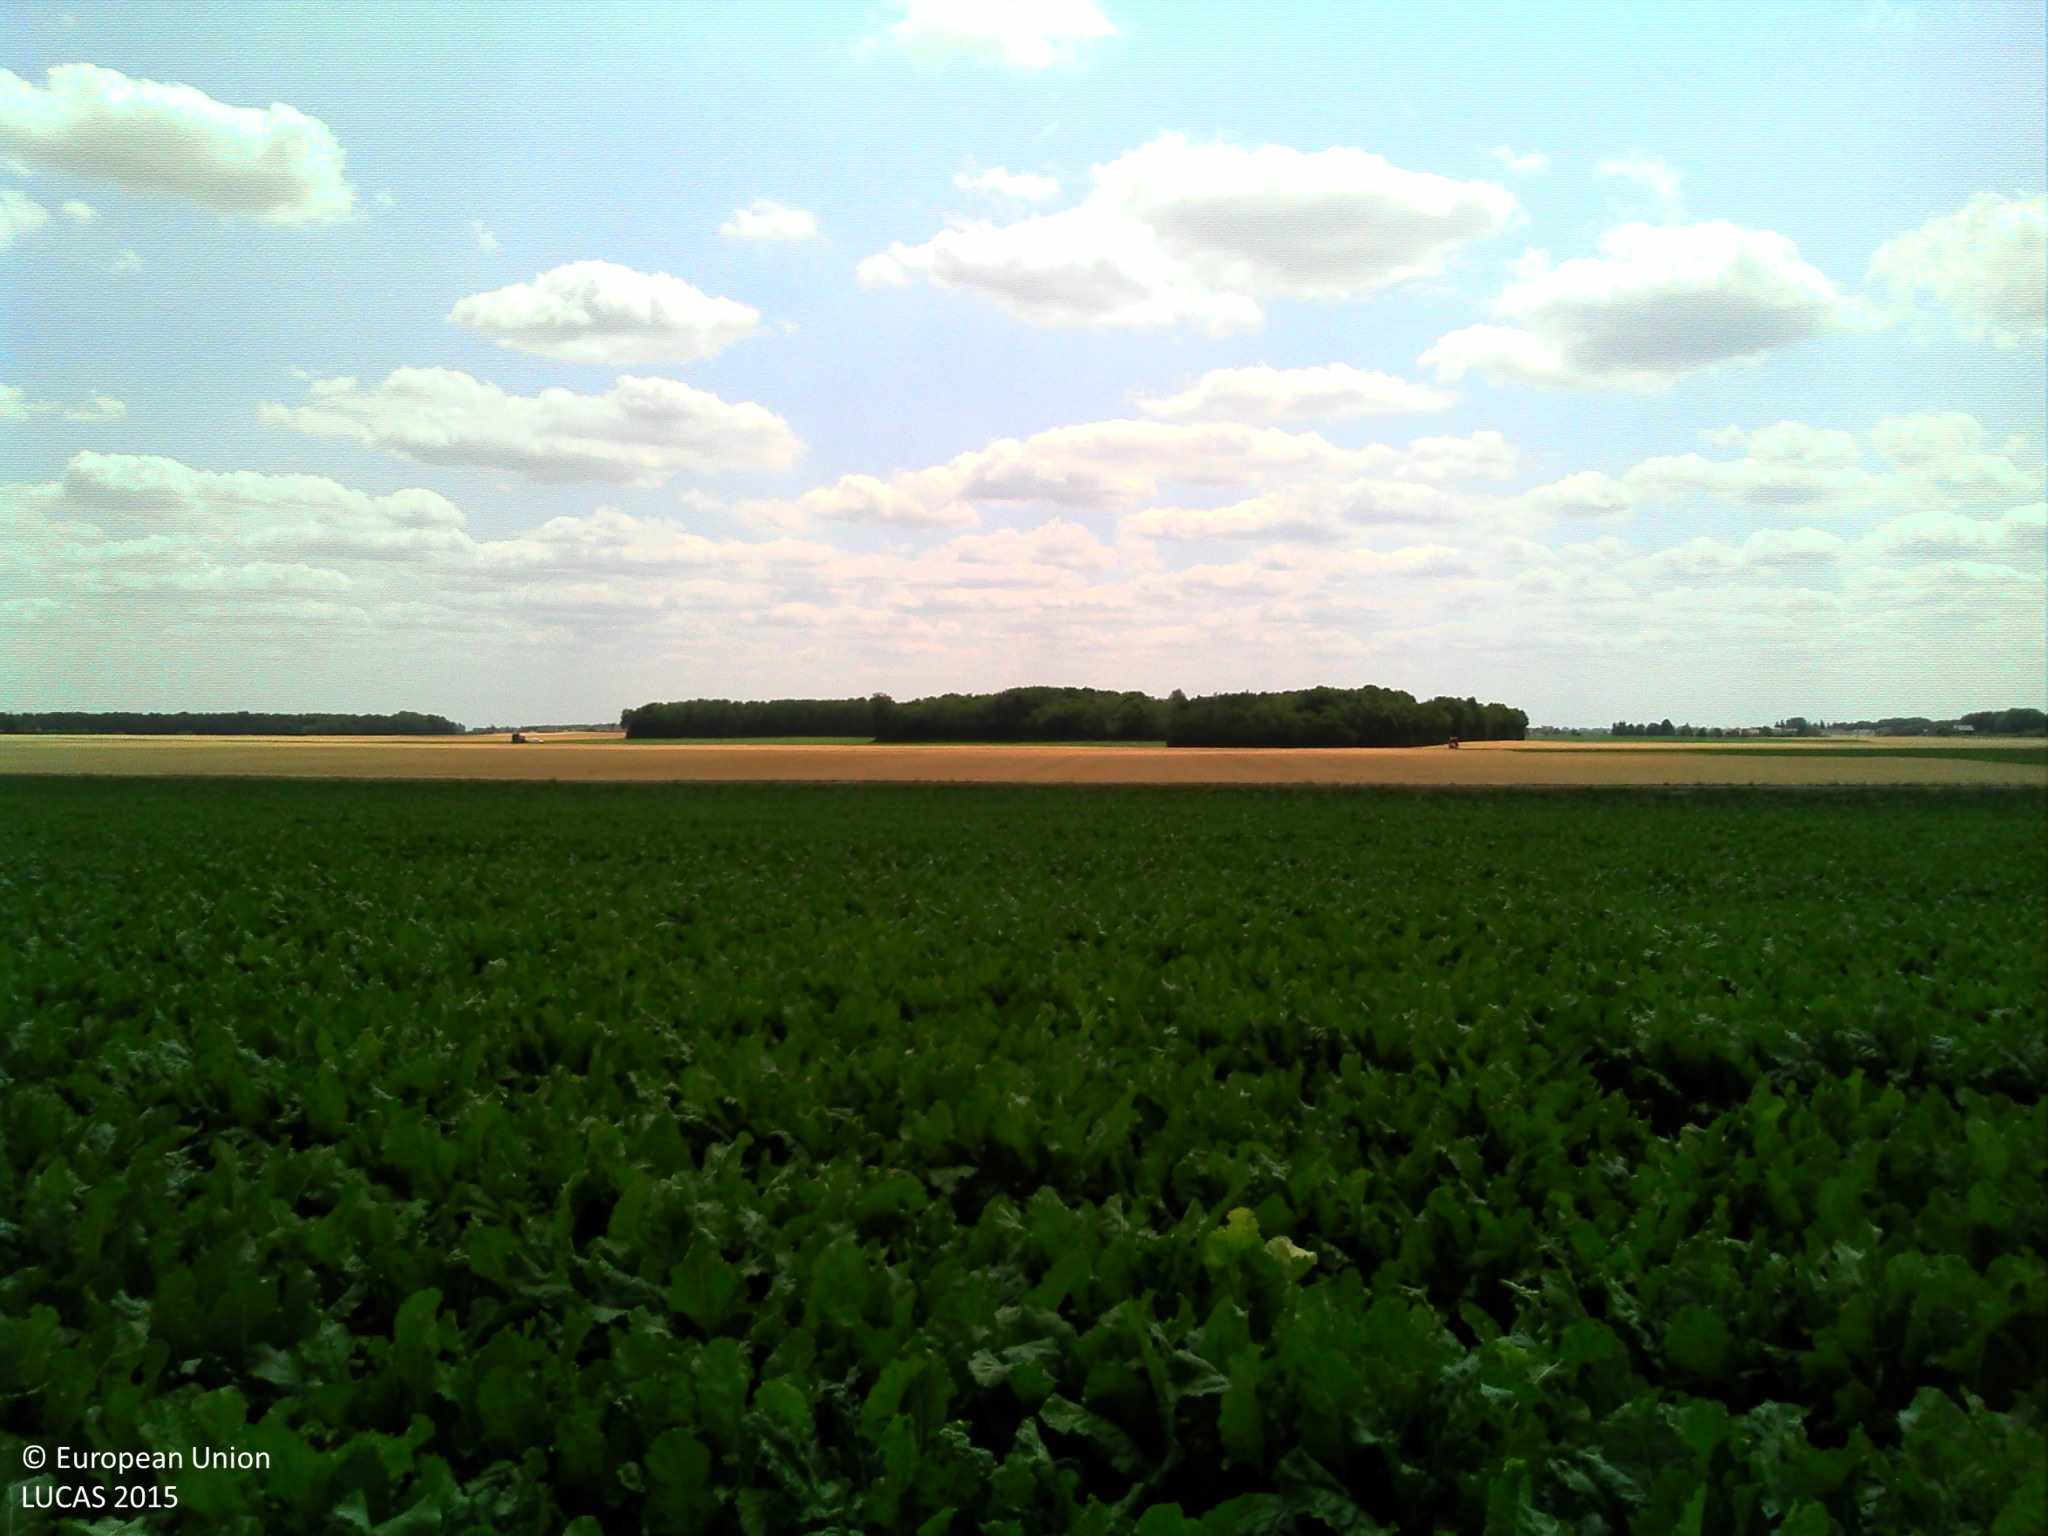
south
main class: Cropland
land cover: Sugar beet
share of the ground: > 75 %
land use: Agriculture (excluding fallow land and kitchen gardens)
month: July
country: FR
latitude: 48.0575
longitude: 2.4900
